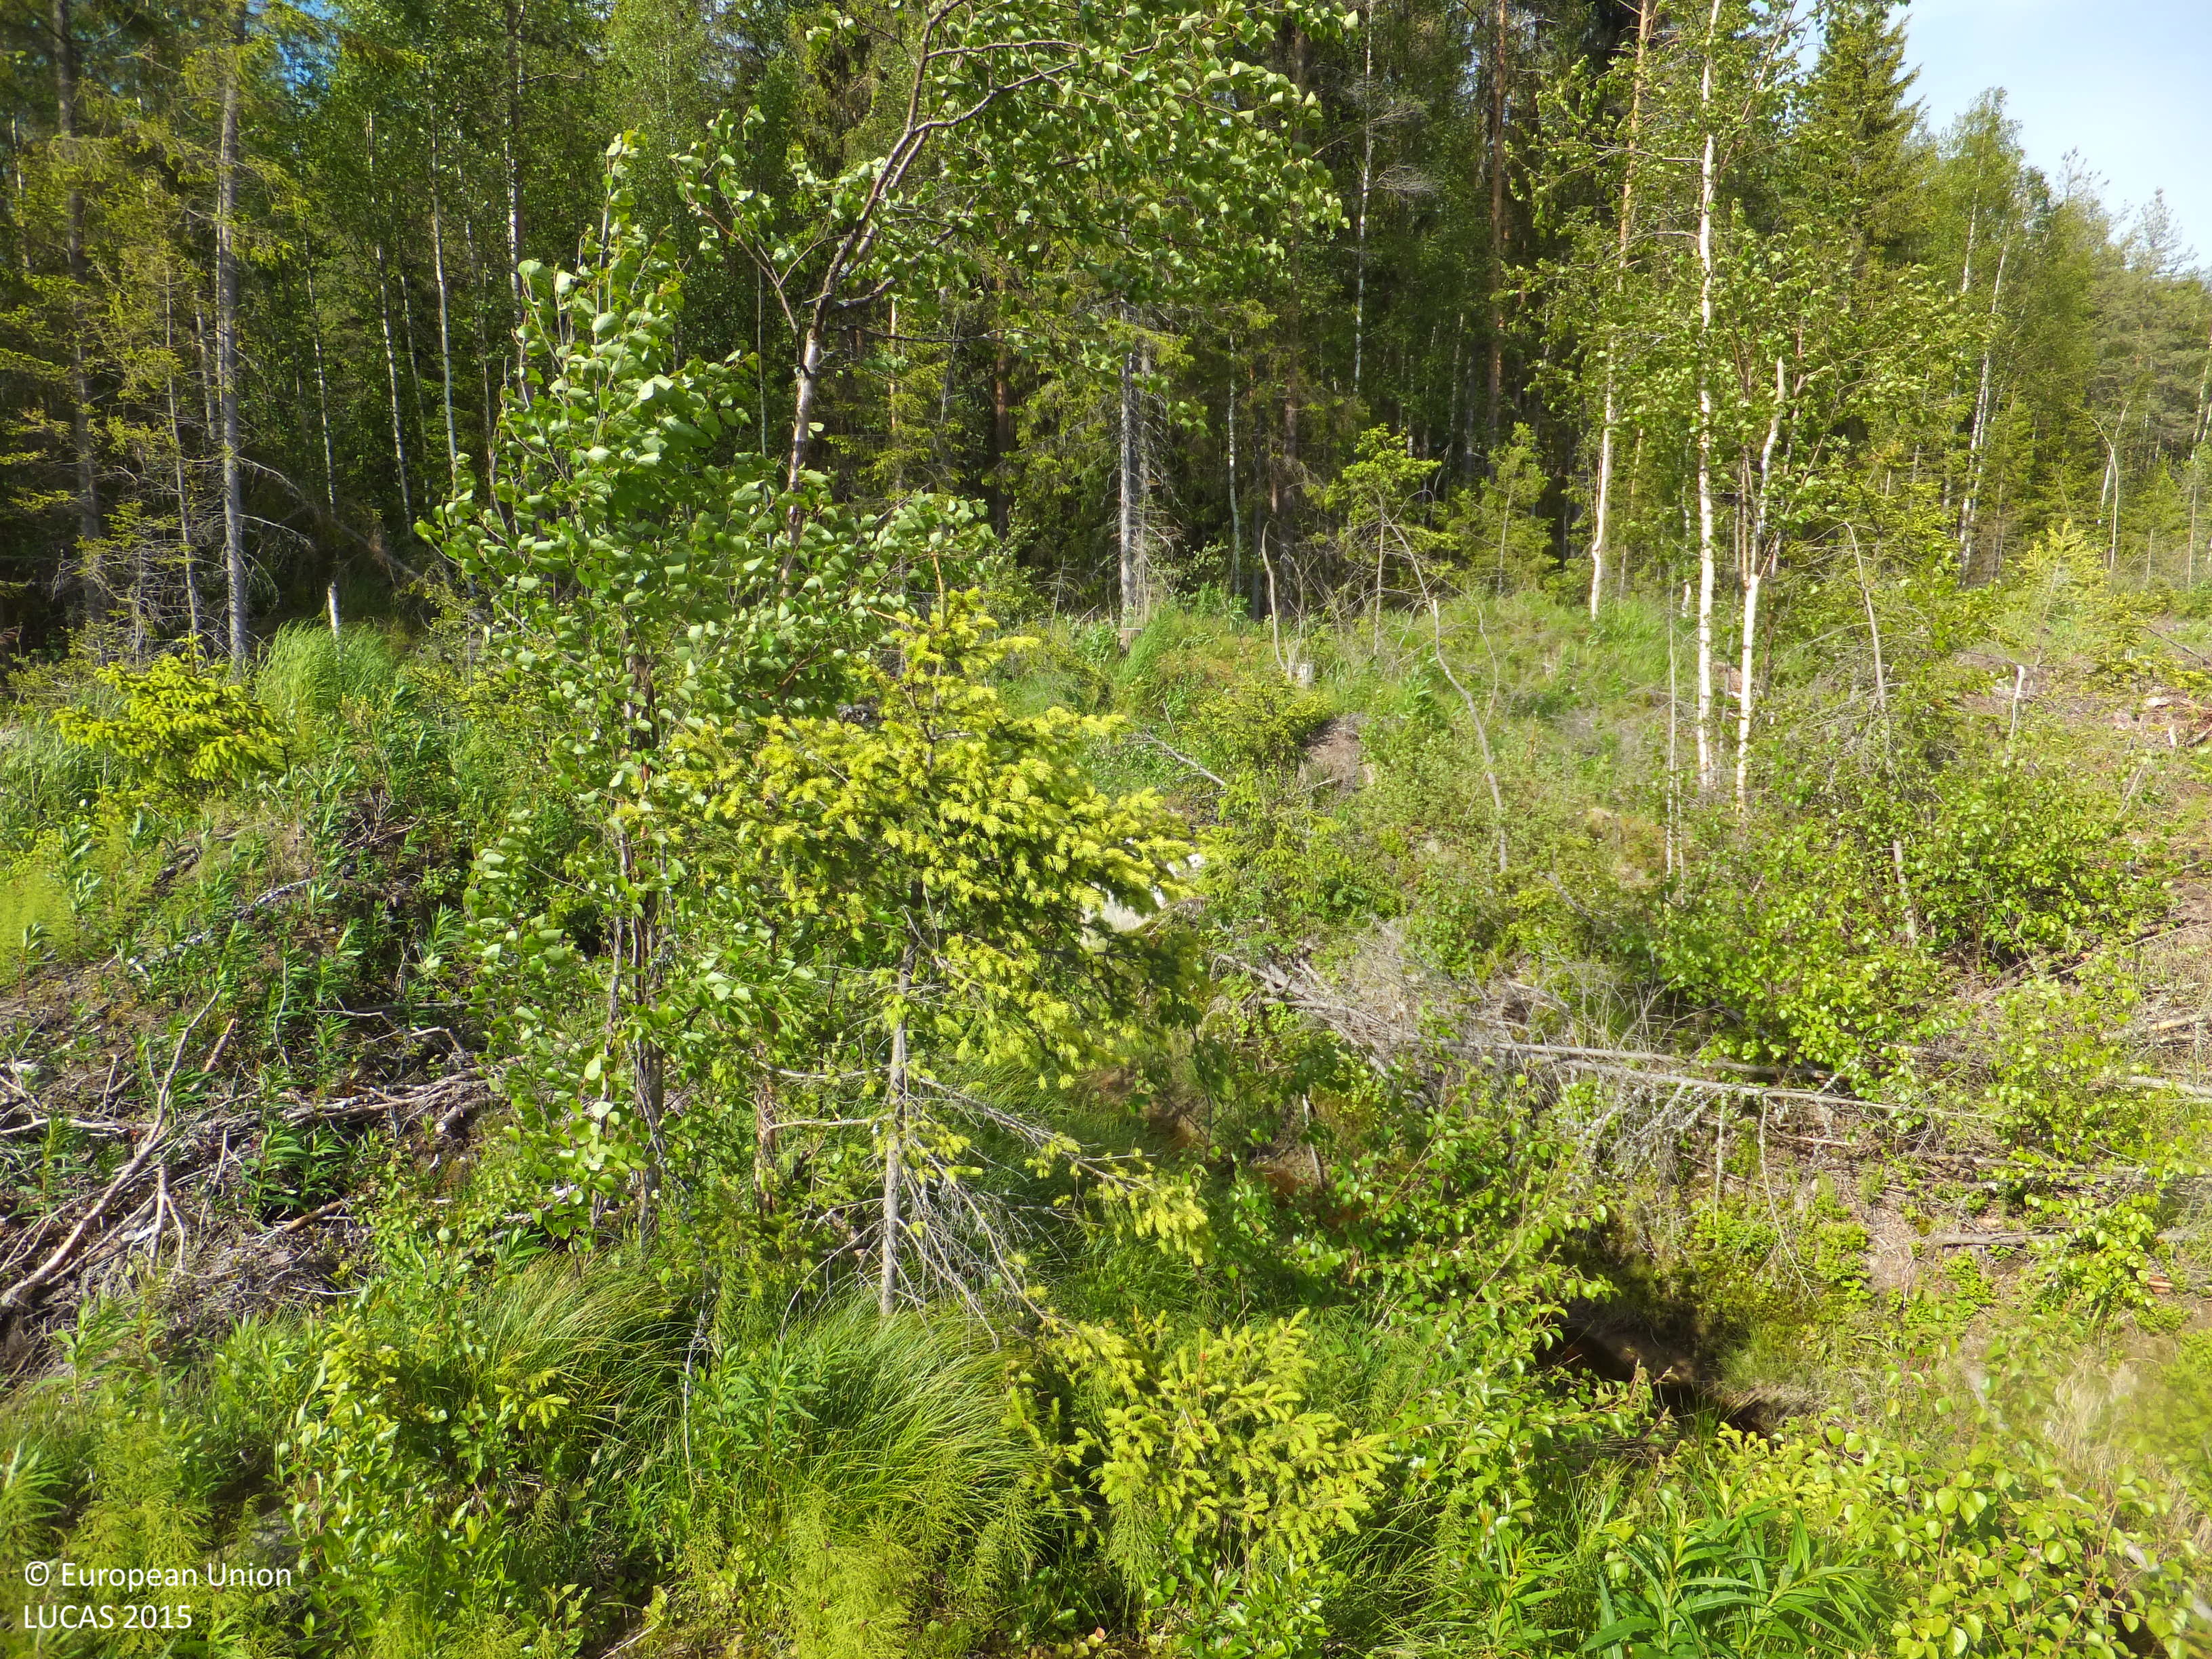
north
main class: Grassland
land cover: Spontaneously vegetated surfaces
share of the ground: 50 - 75 %
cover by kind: herbaceous plants 60 %, unconsolidated bare surface 35 %, shrubs 5 %
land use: Forestry
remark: Clear cut
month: June
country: FI
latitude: 63.2733
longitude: 22.7885
